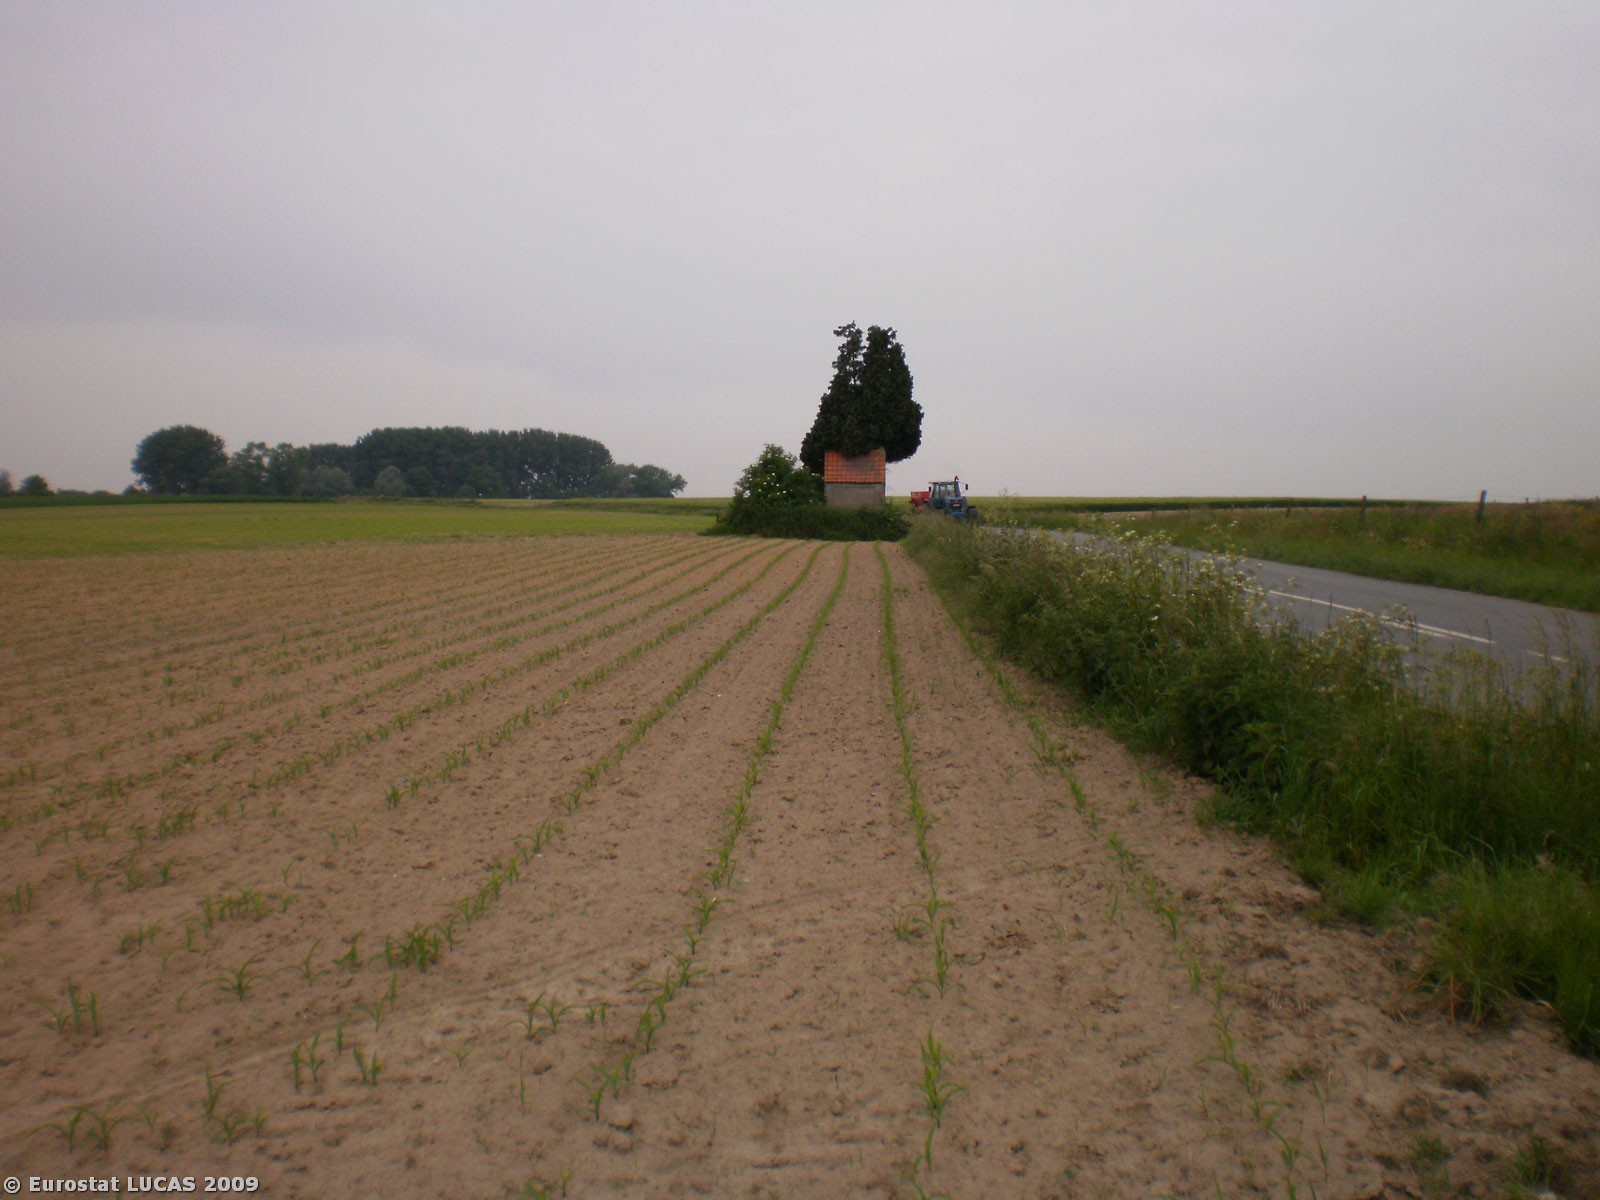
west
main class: Cropland
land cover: Maize
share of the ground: < 10 %
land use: Agriculture (excluding fallow land and kitchen gardens)
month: May
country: BE
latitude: 50.6981
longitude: 3.7497
